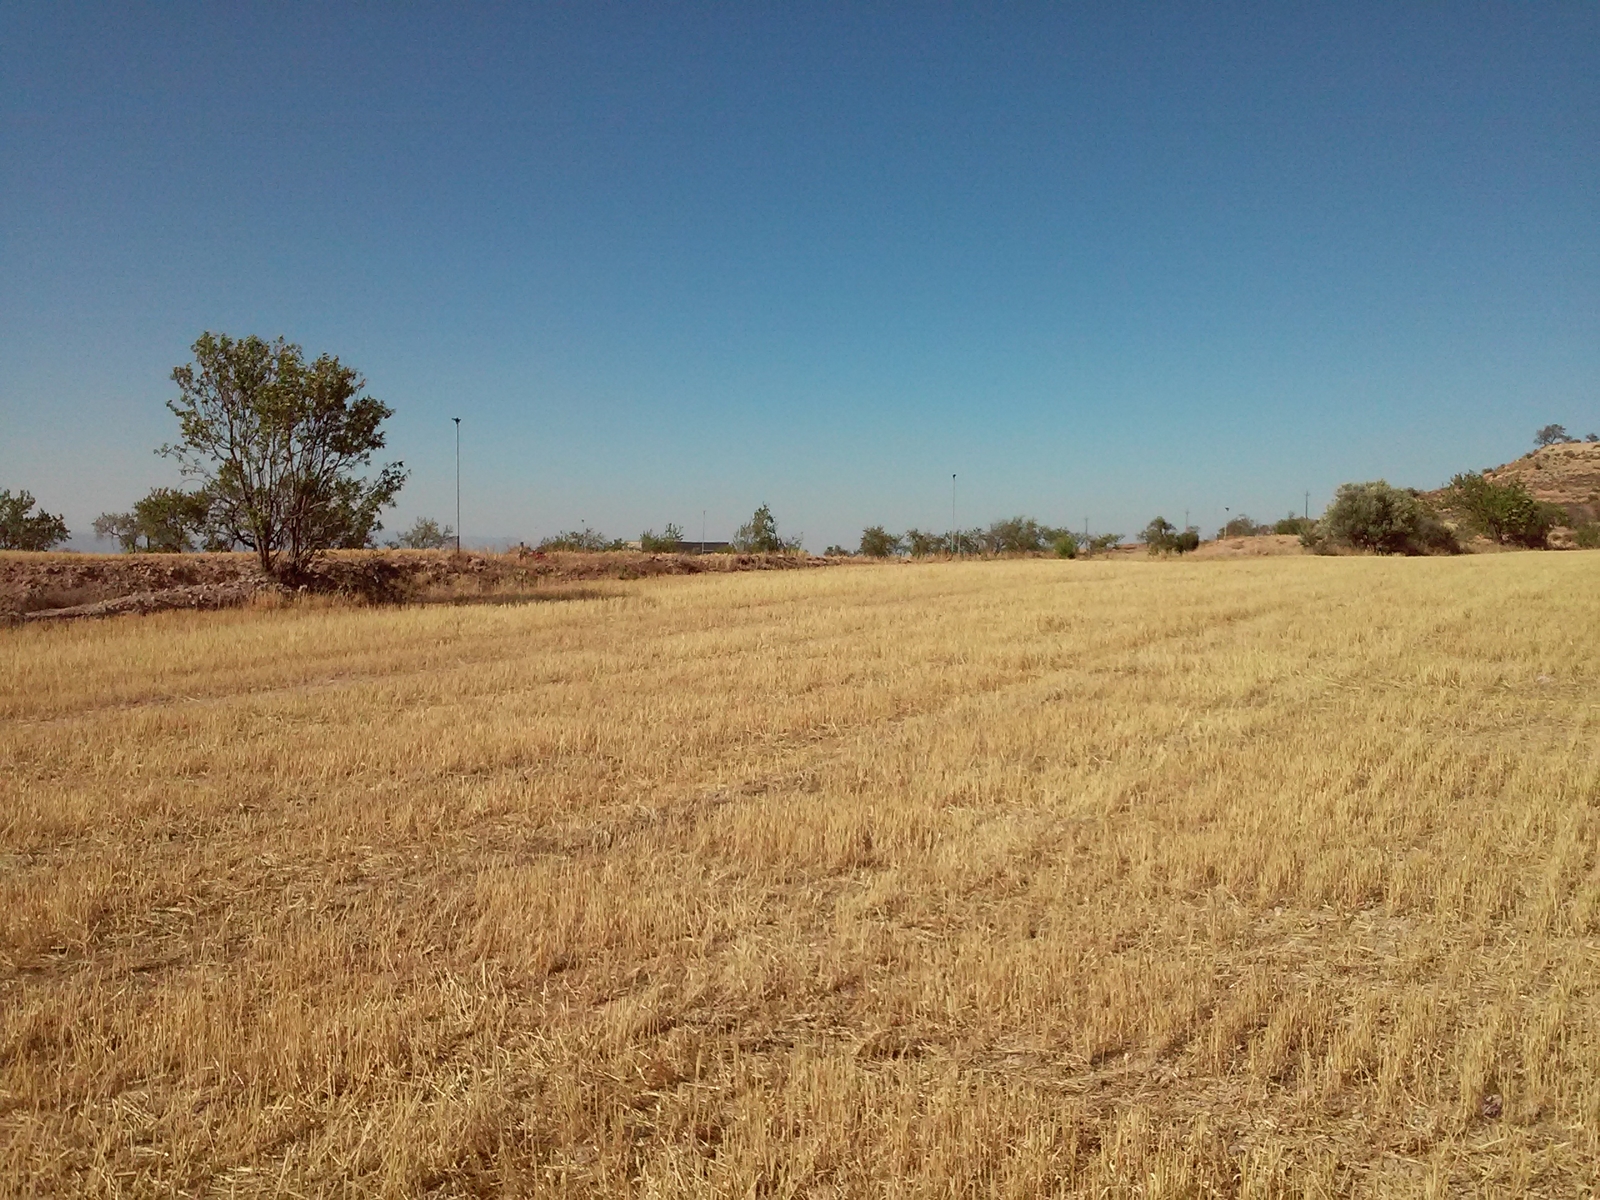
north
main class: Cropland
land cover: Barley
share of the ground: < 10 %
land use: Agriculture (excluding fallow land and kitchen gardens)
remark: Harvested field
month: July
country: ES
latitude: 41.6634
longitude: 1.1142
